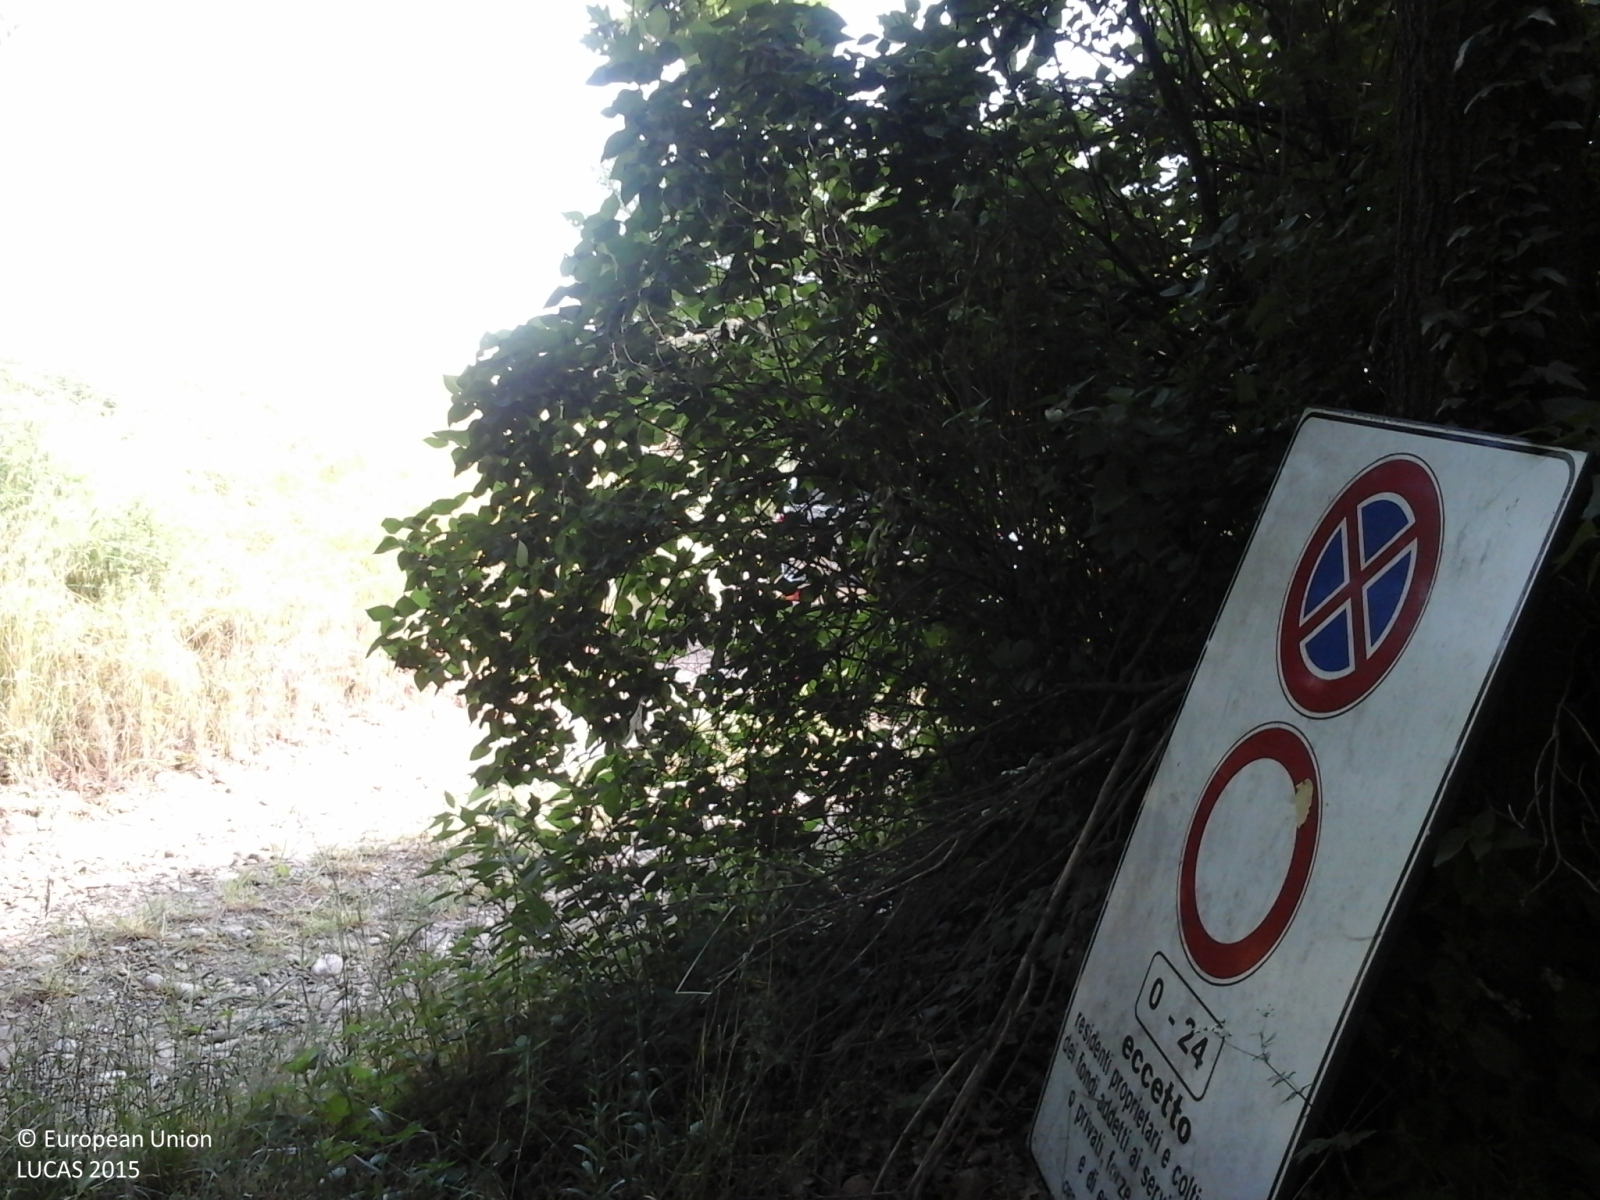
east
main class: Woodland
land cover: Broadleaved woodland
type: thermophilous deciduous forest
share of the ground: > 75 %
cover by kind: broadleaved forest trees 80 %, shrubs 10 %, herbaceous plants 10 %
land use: Forestry
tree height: > 5 m
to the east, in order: Broadleaved woodland; Grassland without tree/shrub cover
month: May
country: IT
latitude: 44.6344
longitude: 7.8235
